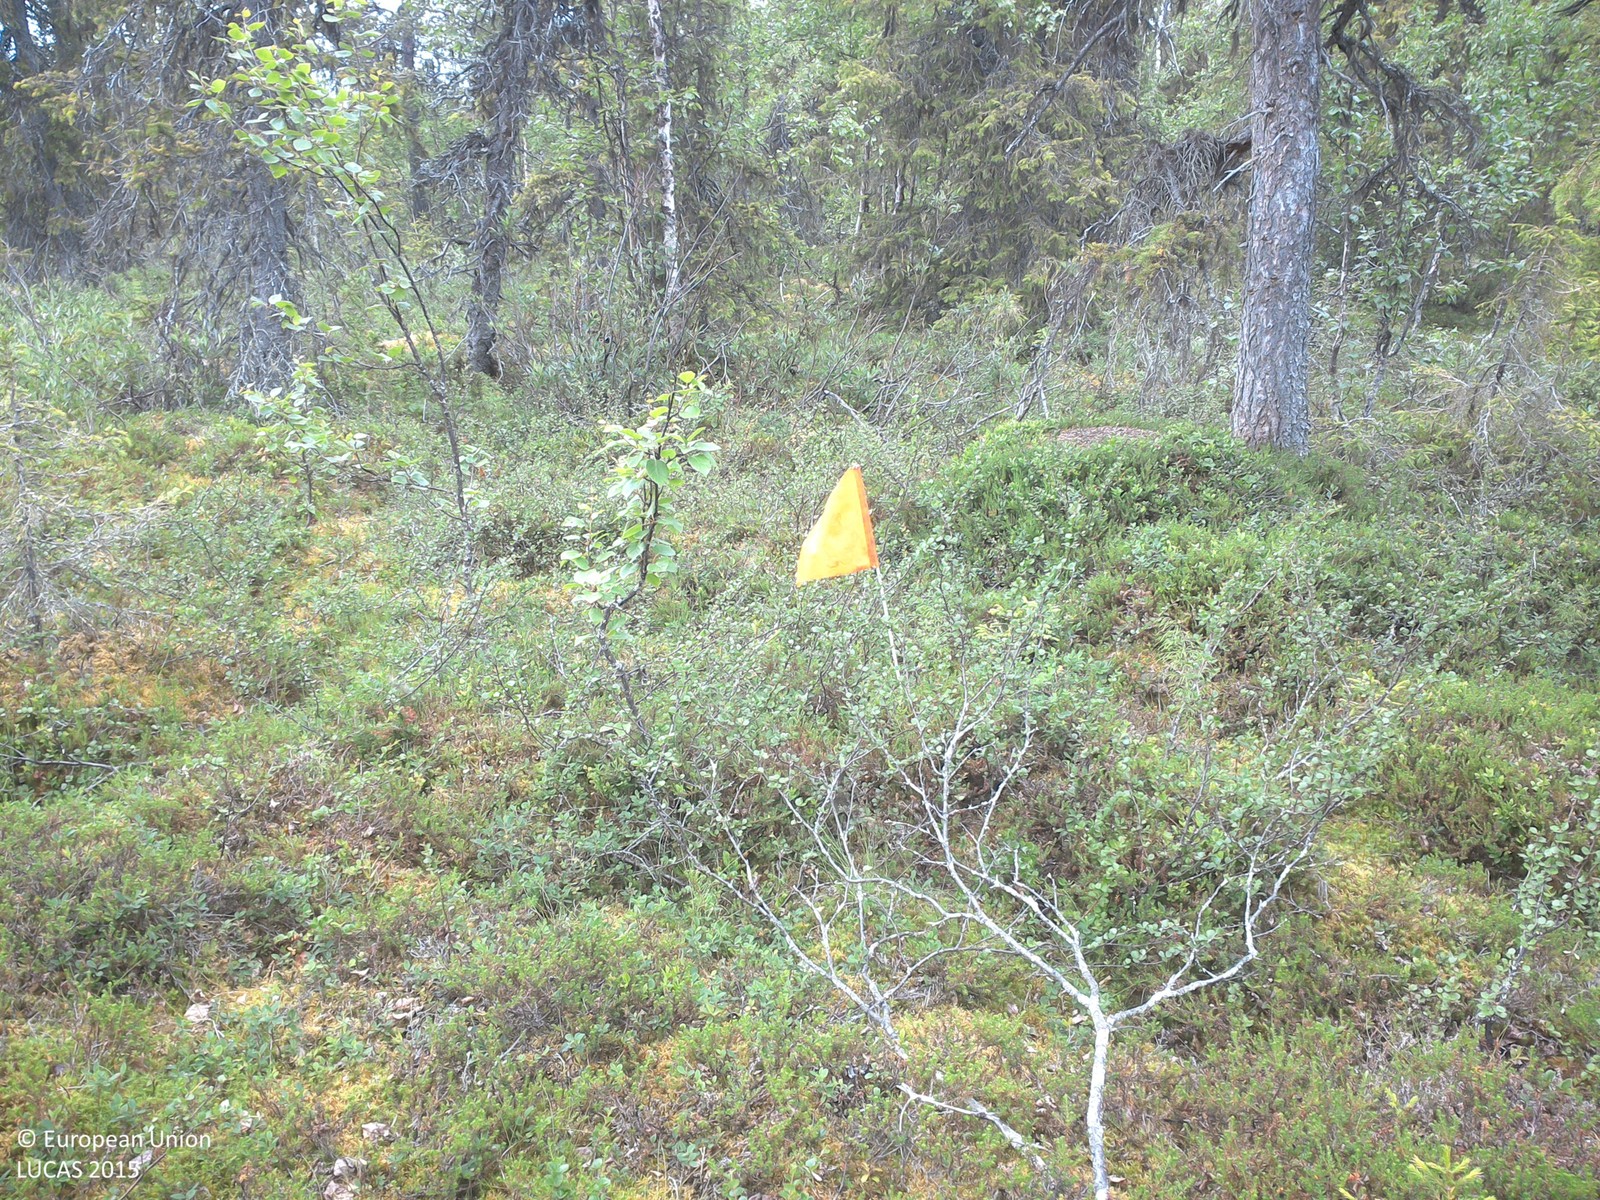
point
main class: Woodland
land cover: Spruce dominated mixed woodland
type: boreal forest
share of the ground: 10 - 25 %
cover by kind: shrubs 70 %, coniferous forest trees 15 %, lichens and mosses 10 %, broadleaved forest trees 5 %
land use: Forestry
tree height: > 5 m
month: July
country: SE
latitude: 67.4780
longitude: 22.0491
